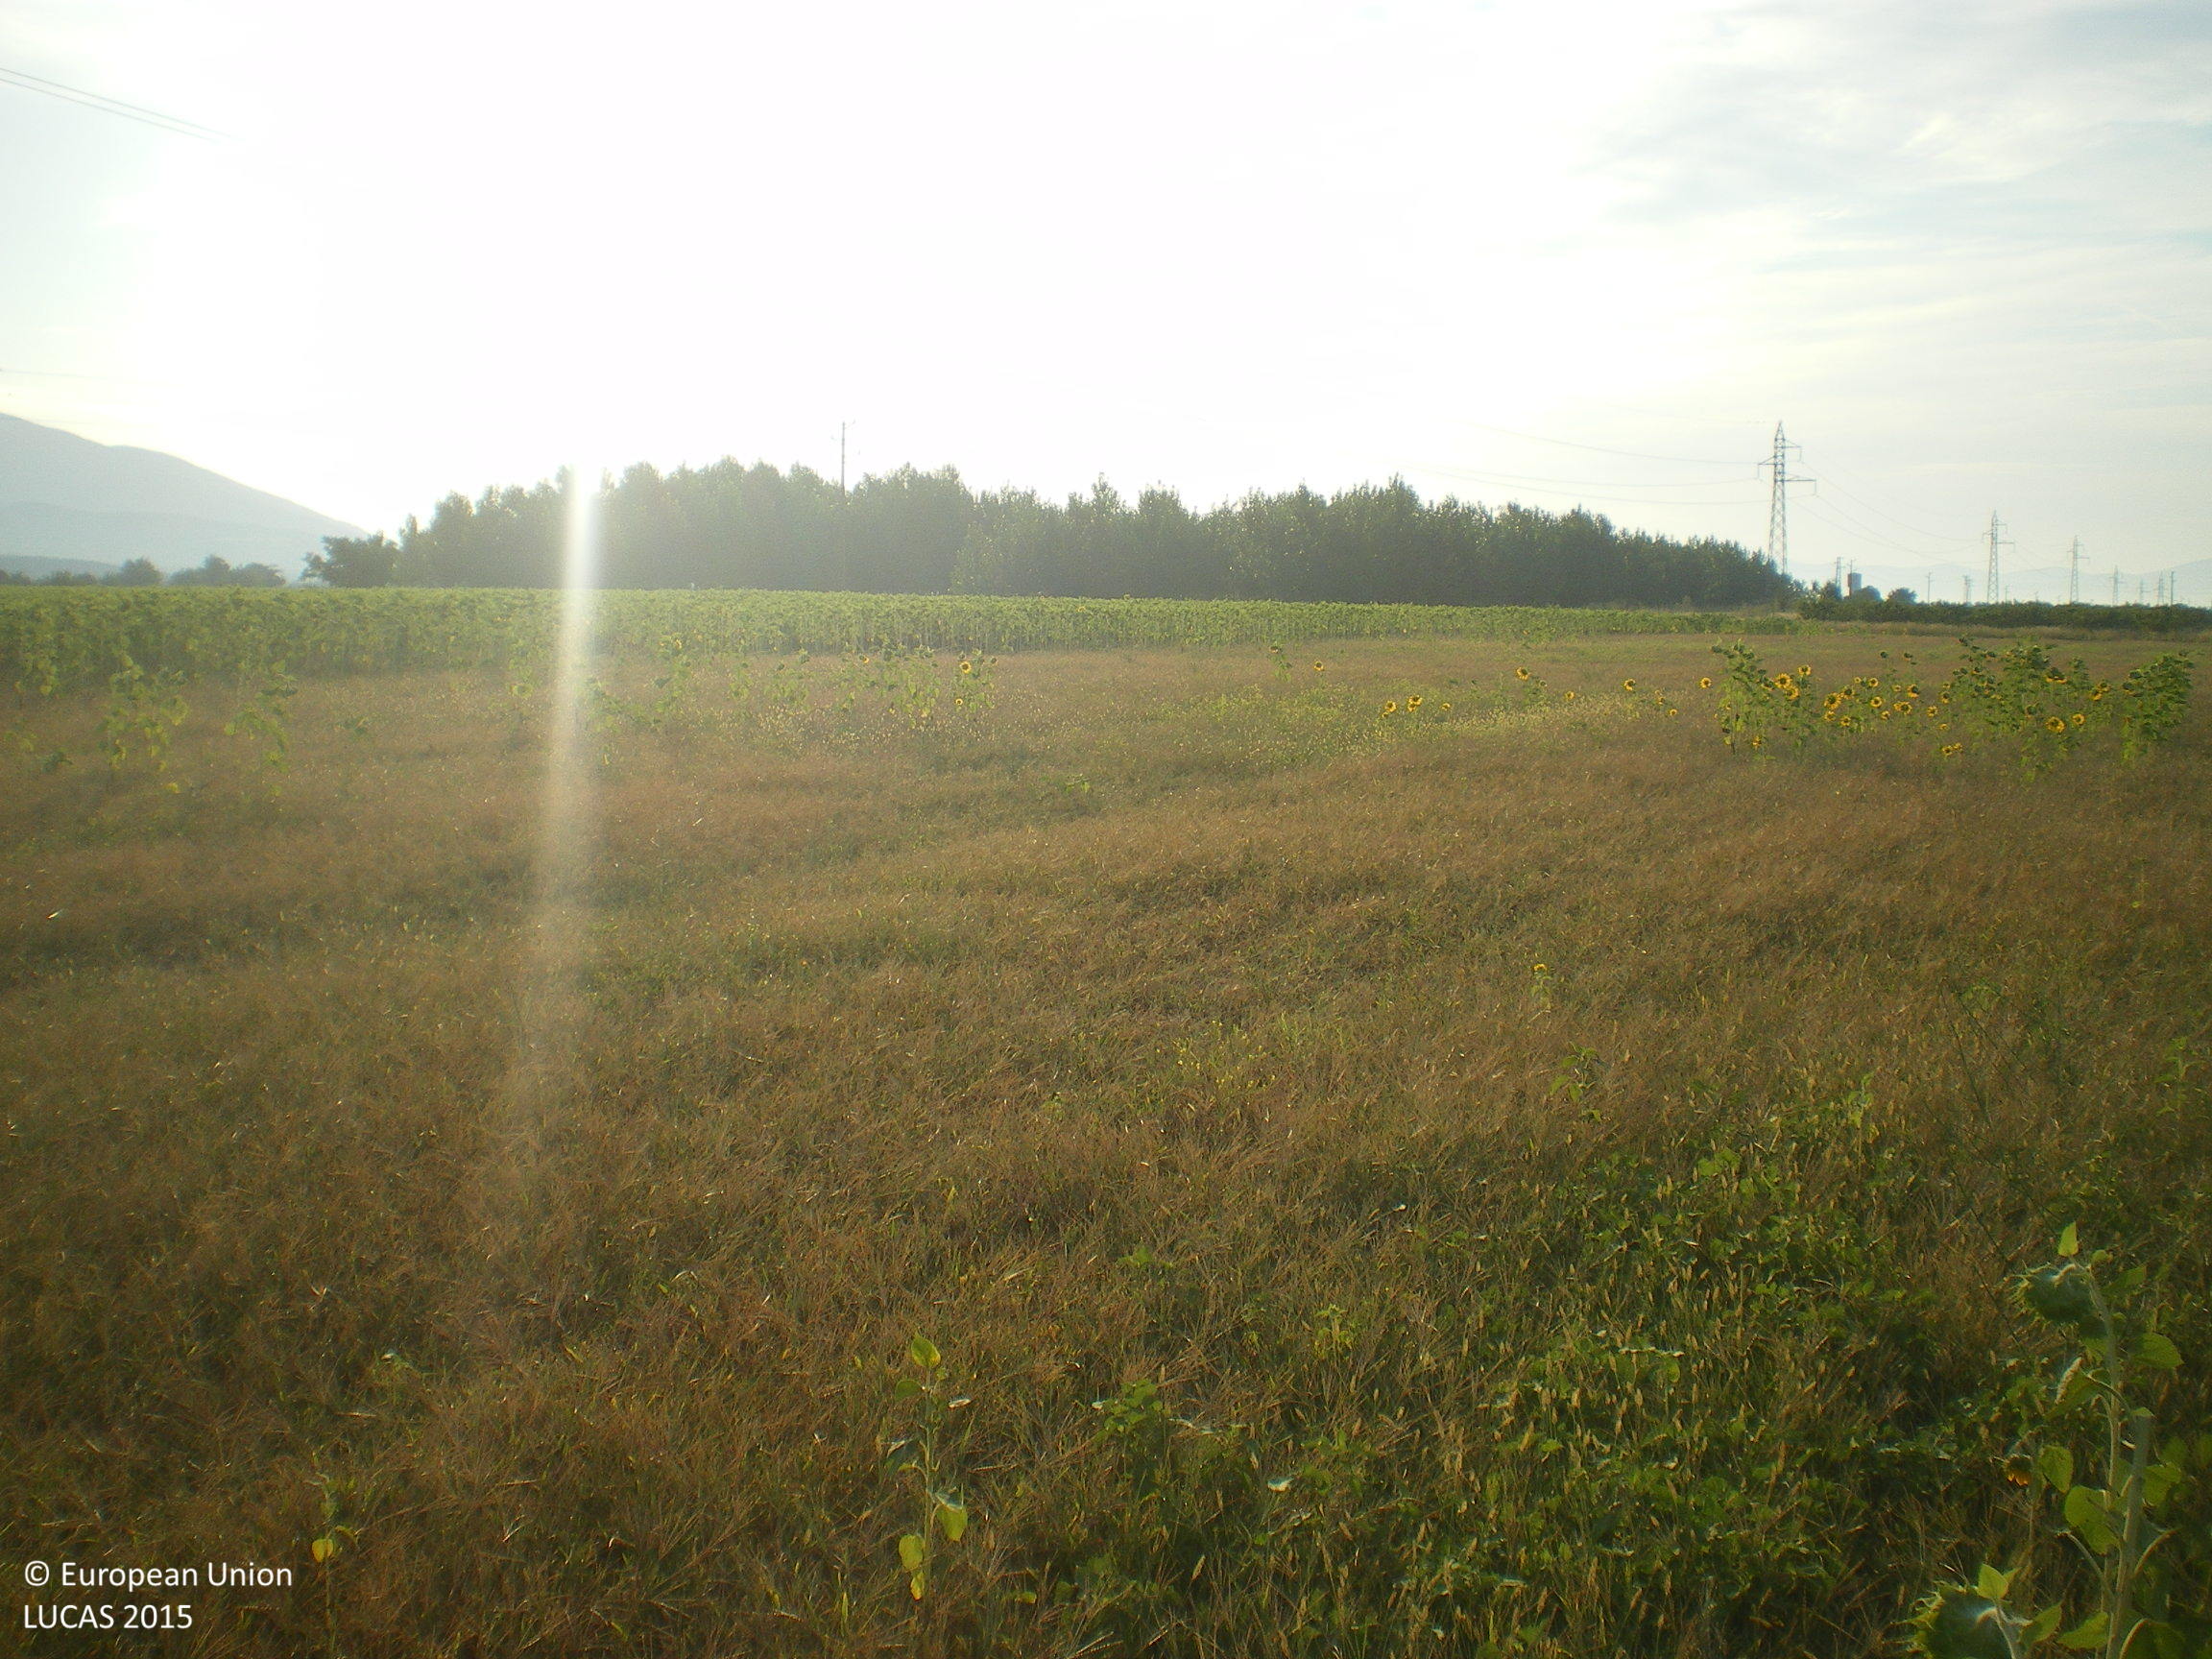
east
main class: Cropland
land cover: Sunflower
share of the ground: < 10 %
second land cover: Spontaneously vegetated surfaces
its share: > 75 %
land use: Agriculture (excluding fallow land and kitchen gardens)
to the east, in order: Sunflower; Spontaneously vegetated surfaces; Sunflower; Electric lines; Sunflower; Electric lines; Sunflower; Permanent industrial crops; Grass margins; Permanent industrial crops
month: August
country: BG
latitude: 42.5961
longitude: 25.4629
